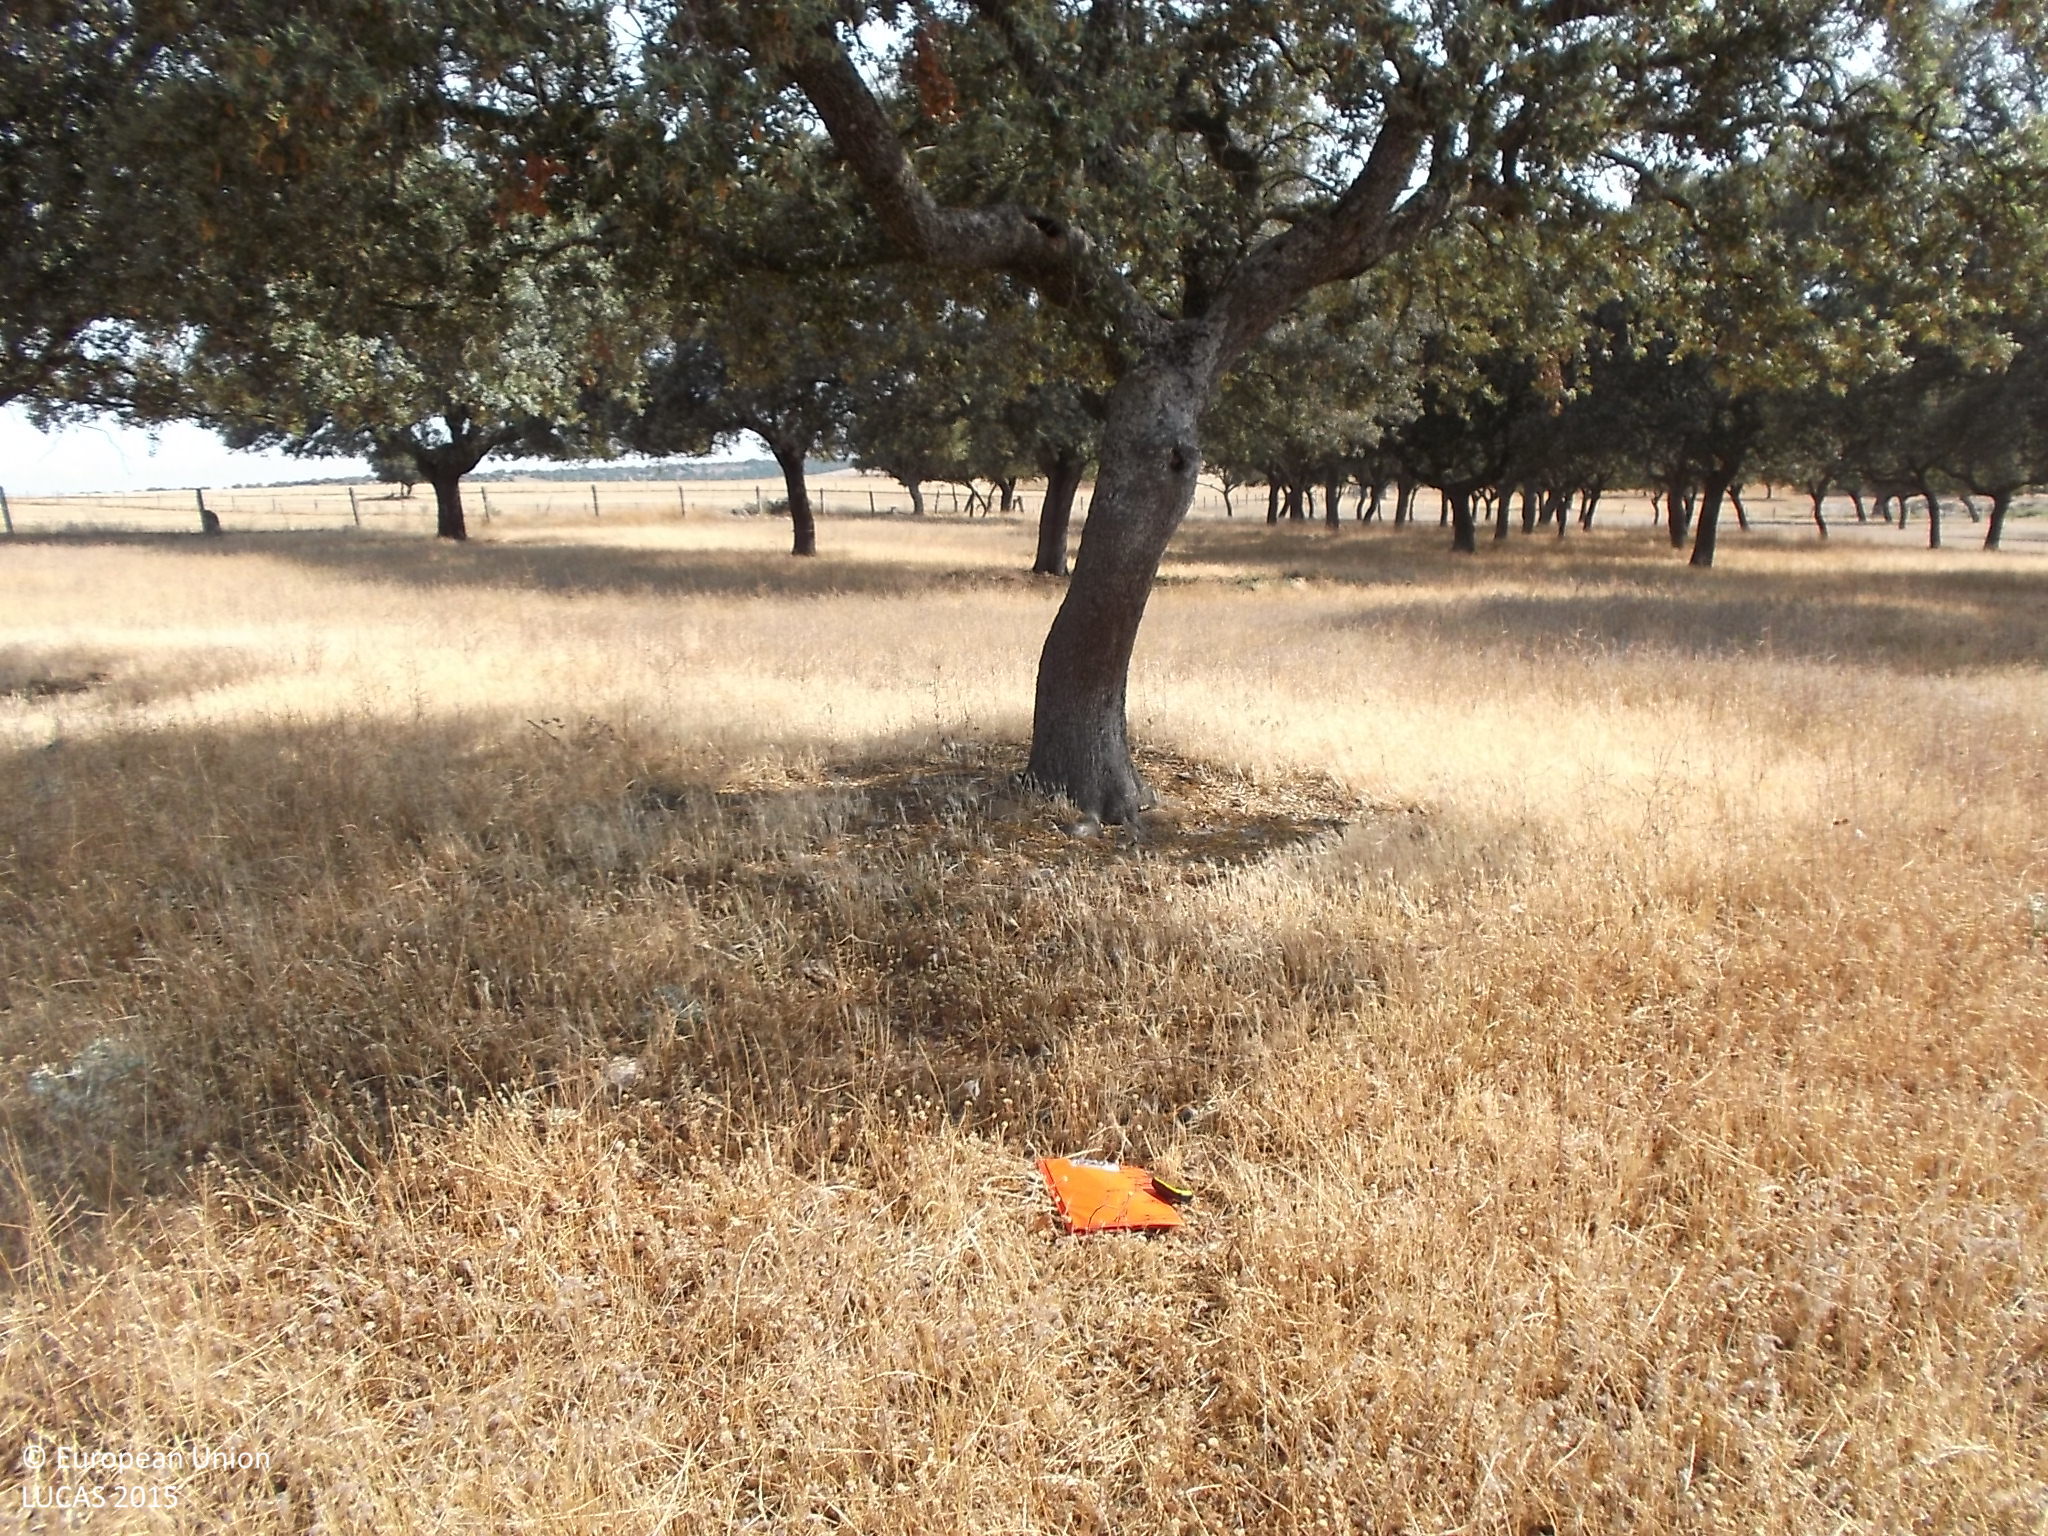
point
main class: Woodland
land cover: Broadleaved woodland
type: broadleaved evergreen forest
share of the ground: 25 - 50 %
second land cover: Grassland without tree/shrub cover
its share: 50 - 75 %
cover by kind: herbaceous plants 70 %, broadleaved forest trees 30 %
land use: Forestry
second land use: Agriculture (excluding fallow land and kitchen gardens)
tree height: < 5 m
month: June
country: ES
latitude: 41.1742
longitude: -5.9758
